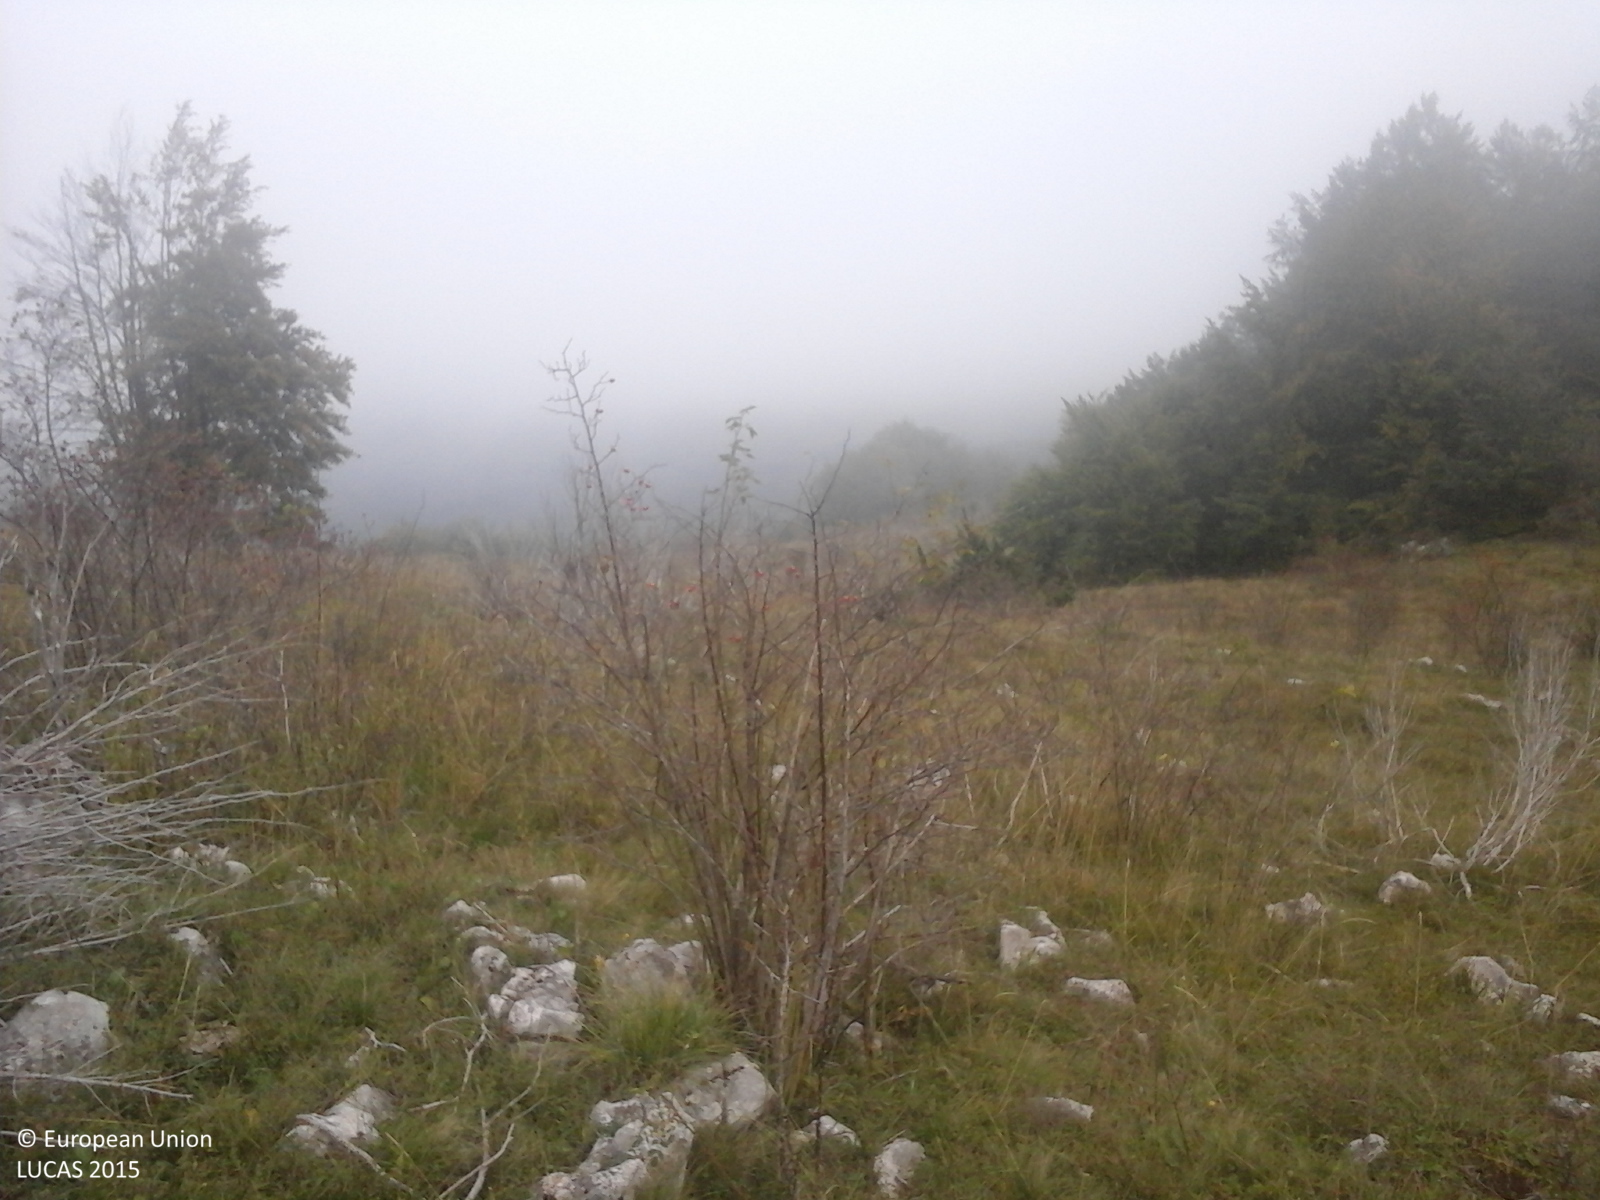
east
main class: Grassland
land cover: Grassland with sparse tree/shrub cover
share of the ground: > 75 %
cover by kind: herbaceous plants 95 %, broadleaved forest trees 5 %
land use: Agriculture (excluding fallow land and kitchen gardens)
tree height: > 5 m
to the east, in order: Grassland with sparse tree/shrub cover; Broadleaved woodland
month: October
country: RO
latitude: 46.3321
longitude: 23.4854
